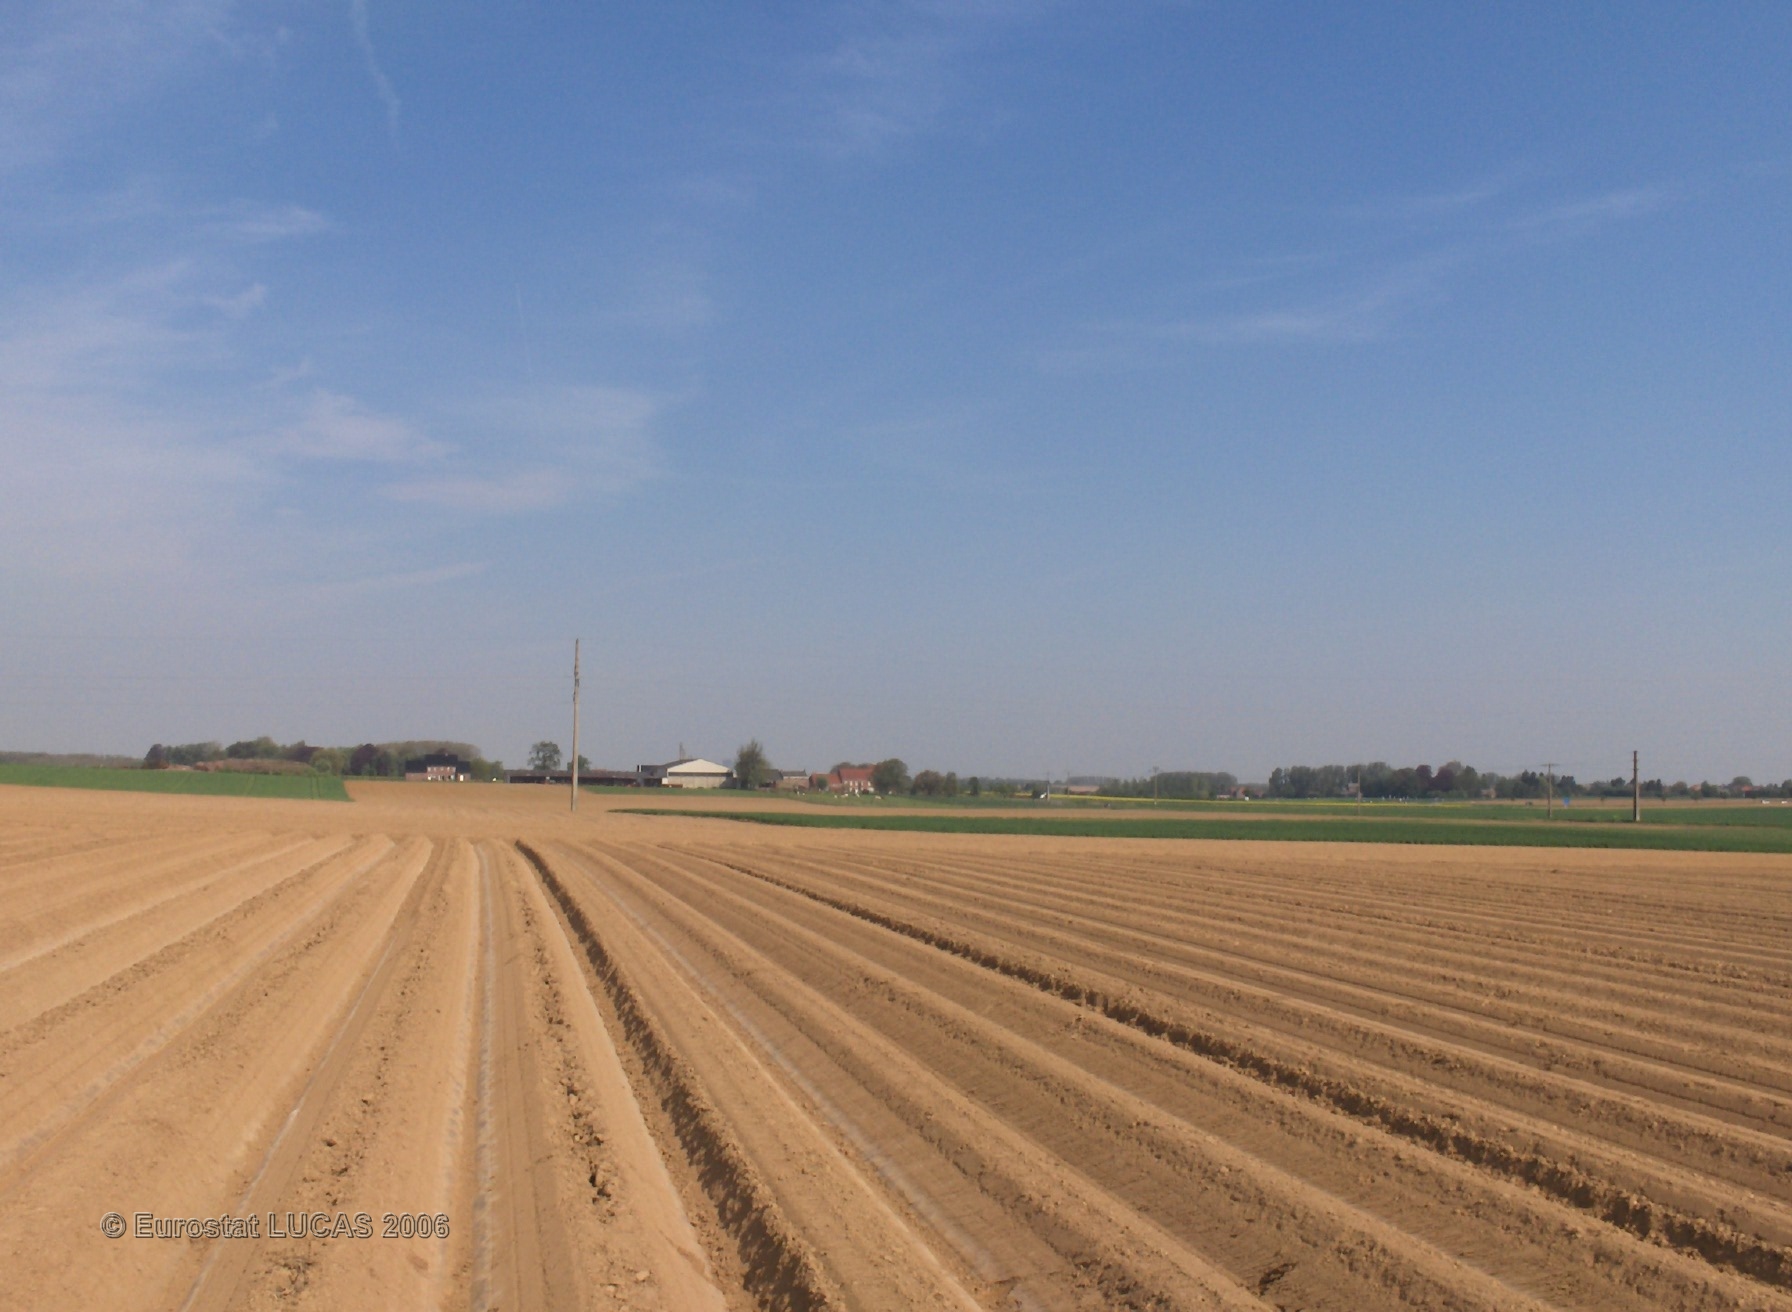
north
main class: Cropland
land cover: Potatoes
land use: Agriculture (excluding fallow land and kitchen gardens)
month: May
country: BE
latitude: 50.6609
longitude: 5.2302
